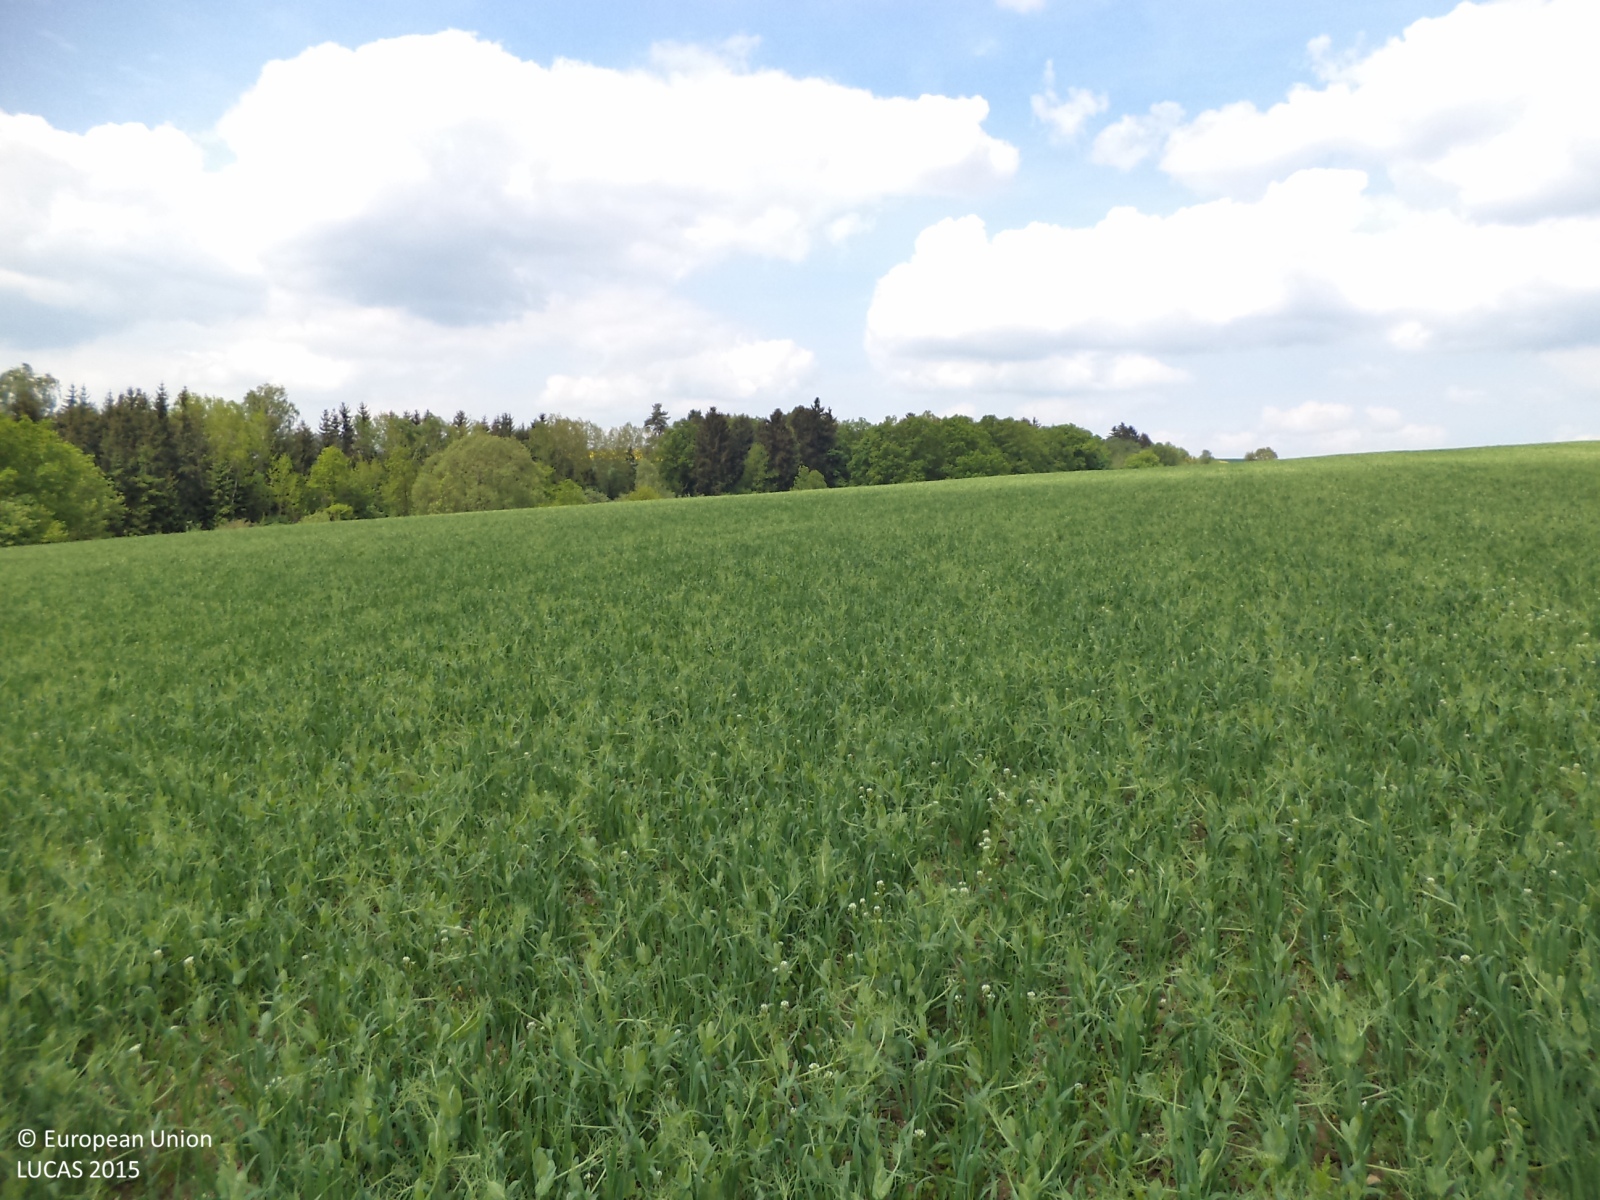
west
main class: Cropland
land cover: Mixed cereals for fodder
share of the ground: > 75 %
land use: Agriculture (excluding fallow land and kitchen gardens)
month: May
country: CZ
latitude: 49.5833
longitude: 15.1066
